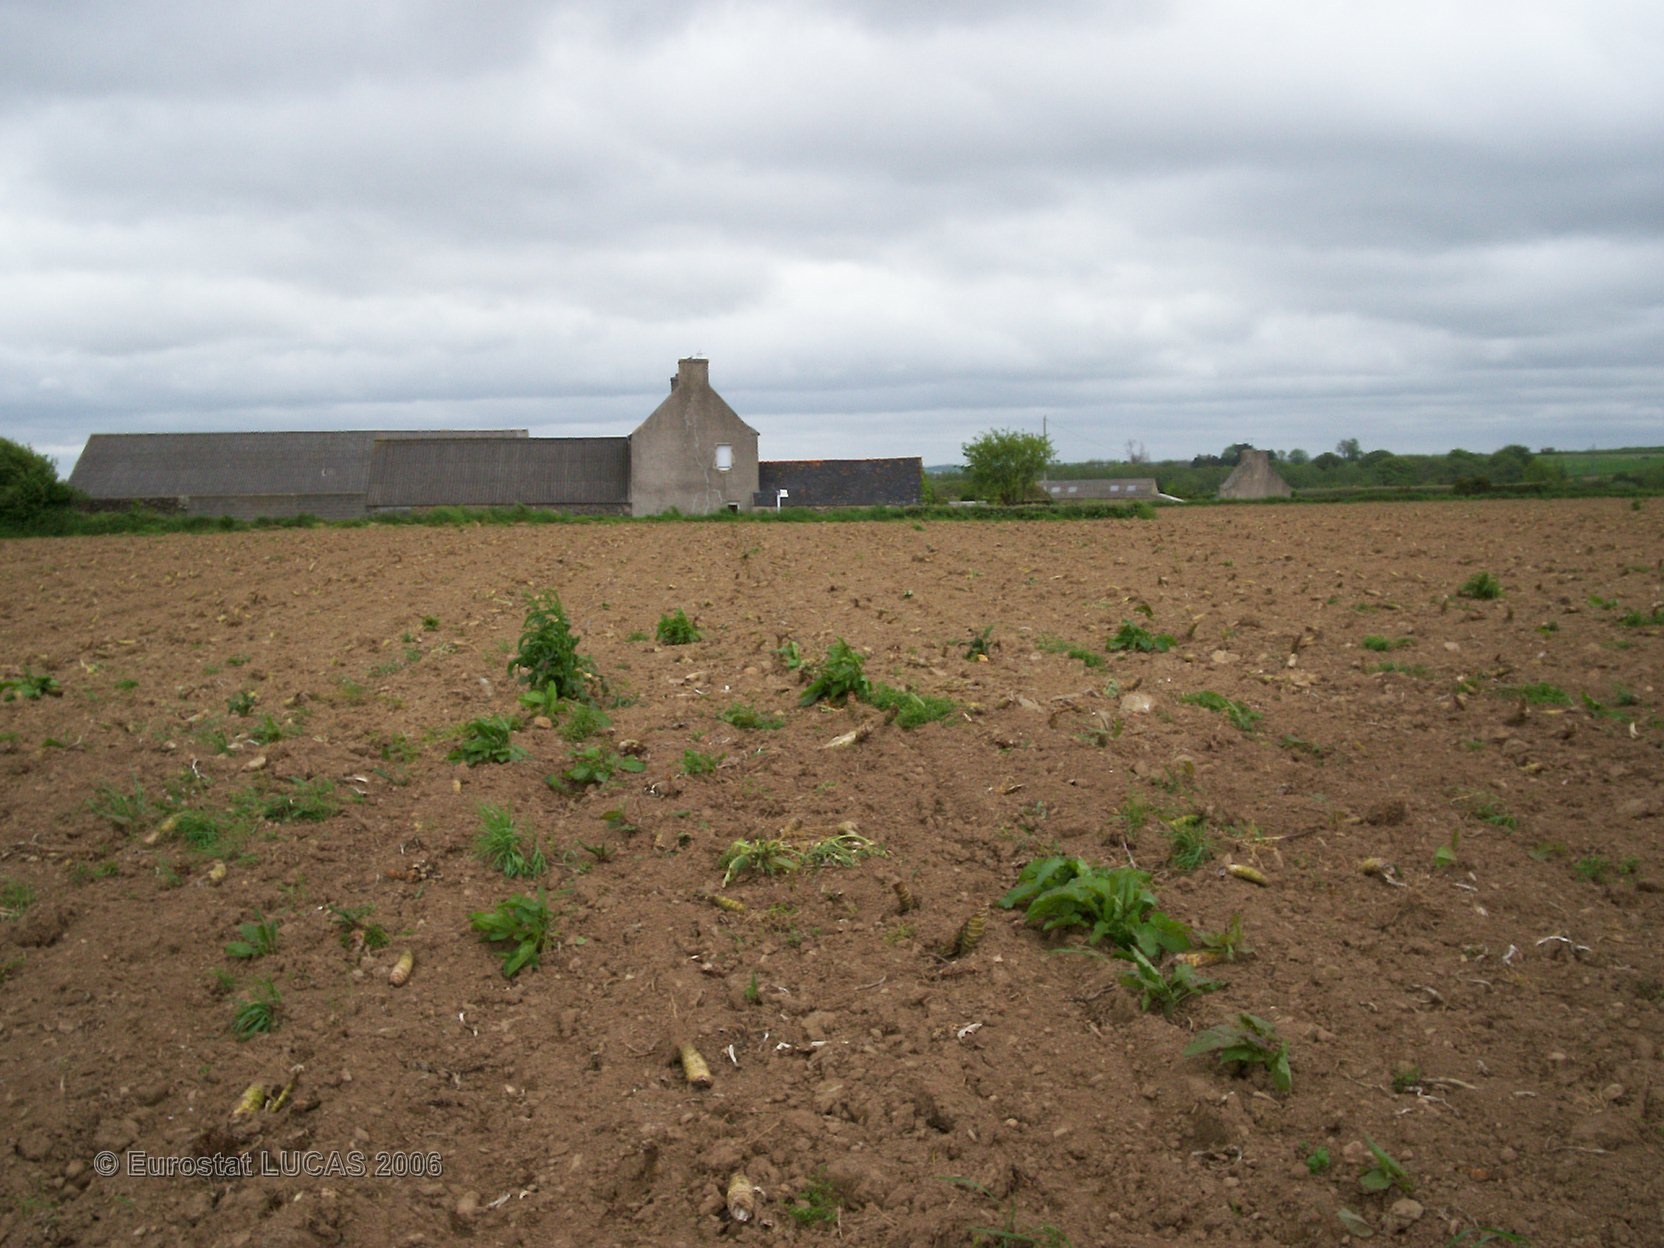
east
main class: Bare land
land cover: Bare land
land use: Agriculture (excluding fallow land and kitchen gardens)
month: May
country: FR
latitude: 48.6588
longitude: -3.7003
